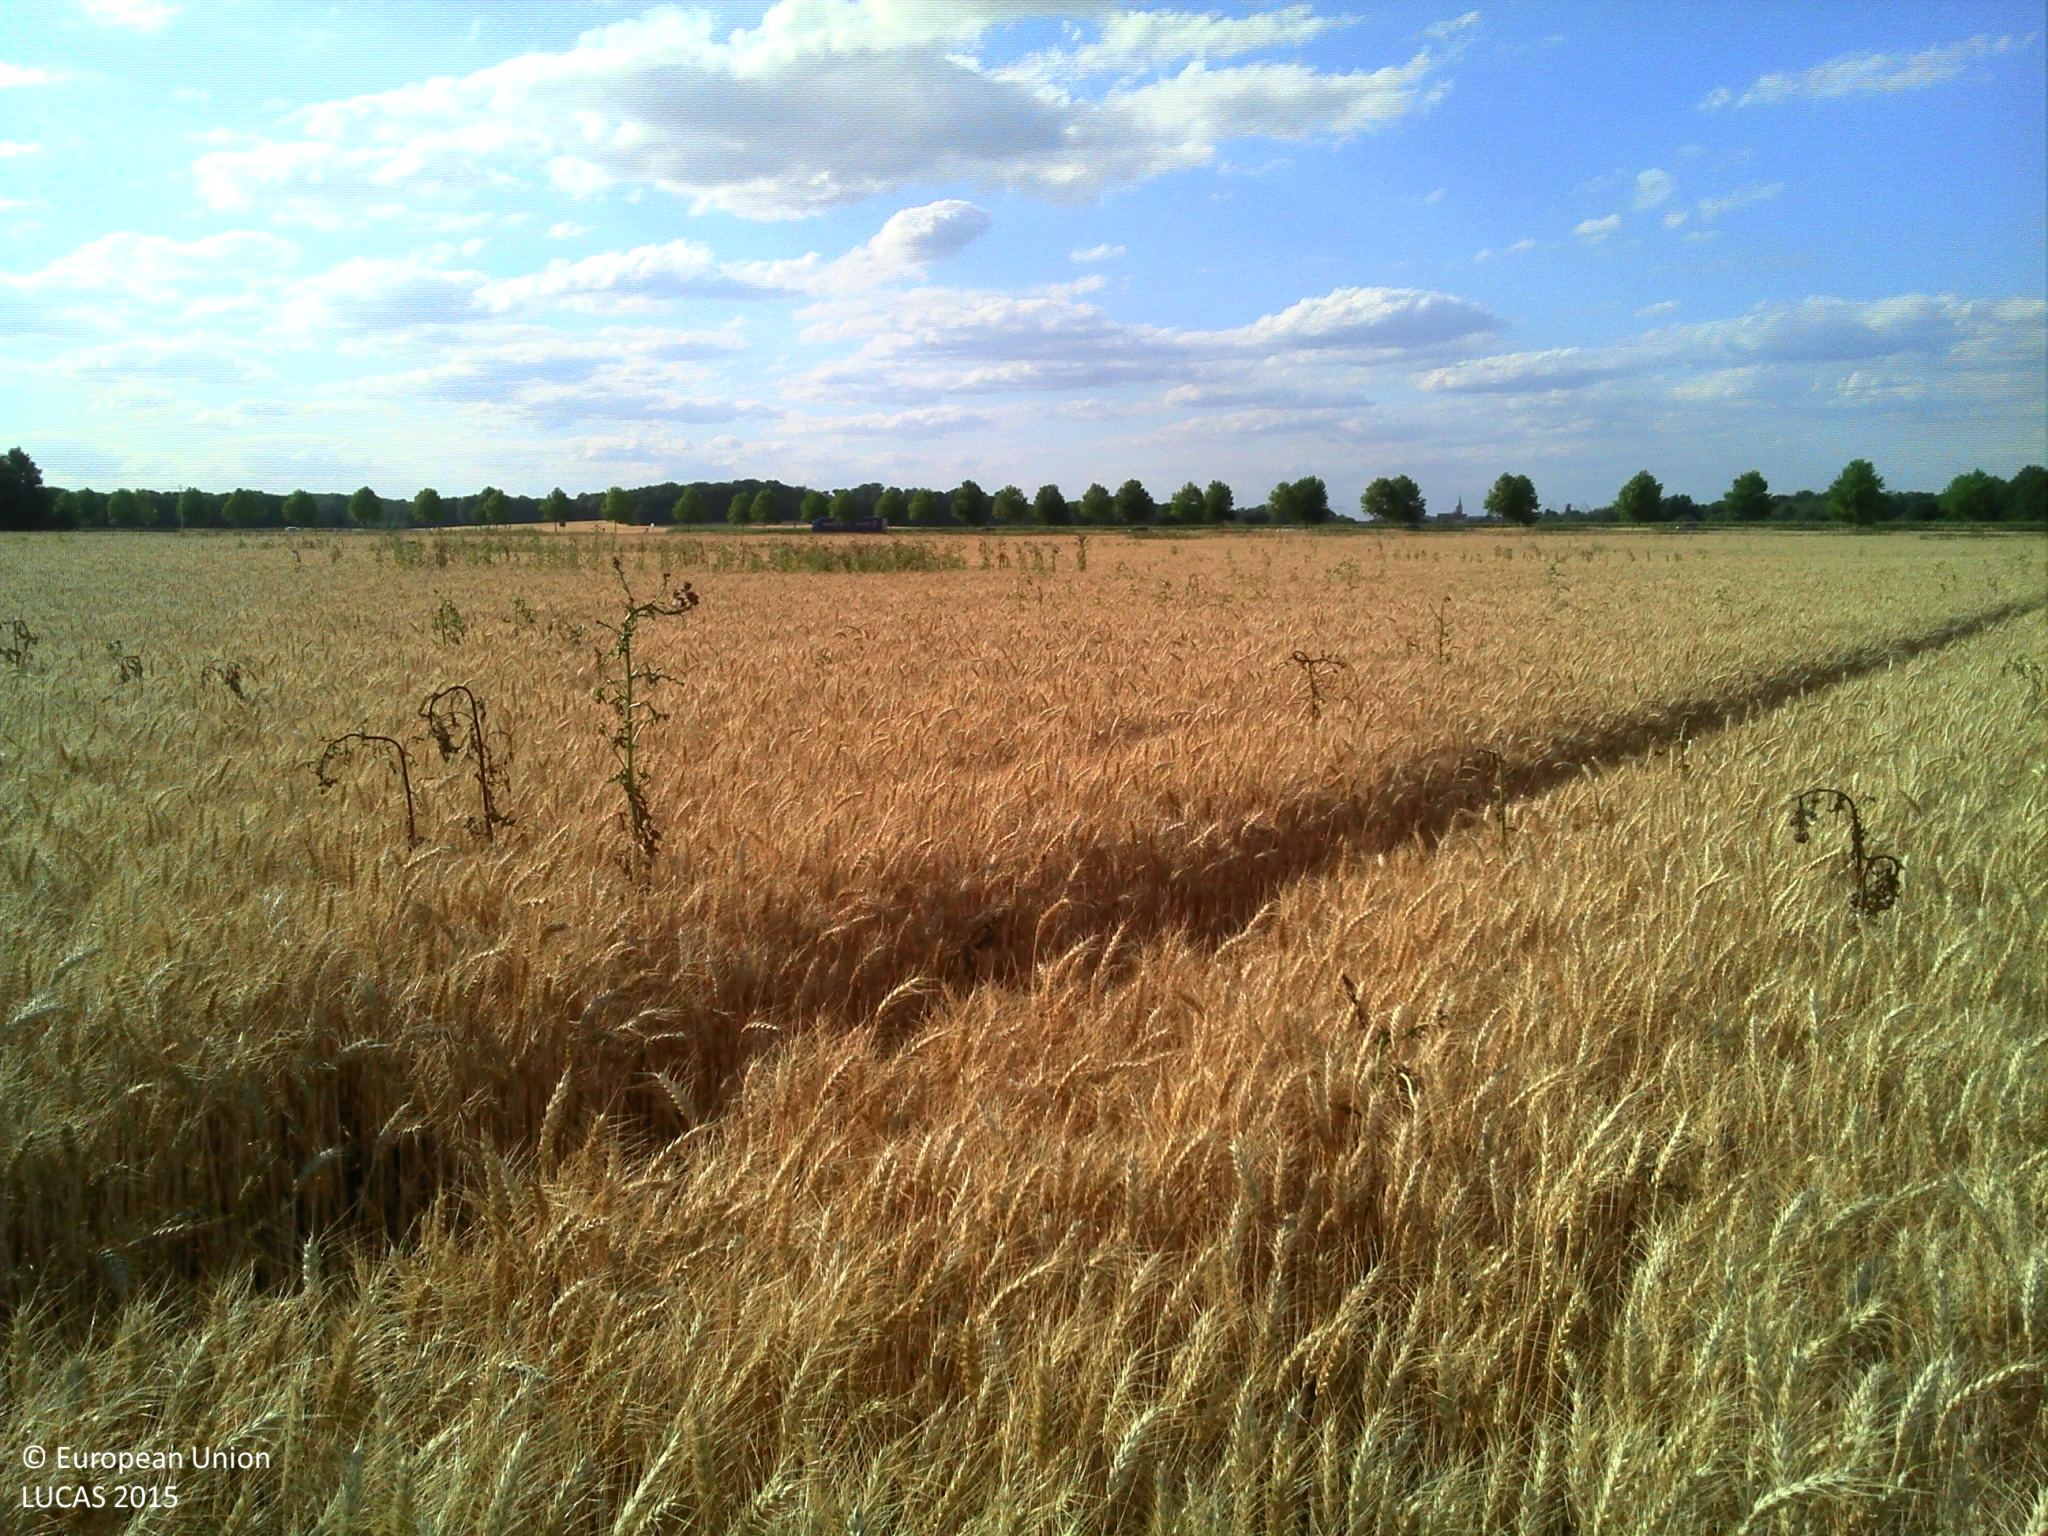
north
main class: Cropland
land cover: Common wheat
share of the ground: > 75 %
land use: Agriculture (excluding fallow land and kitchen gardens)
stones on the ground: < 10 %
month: July
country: FR
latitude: 48.5443
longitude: 2.7437
